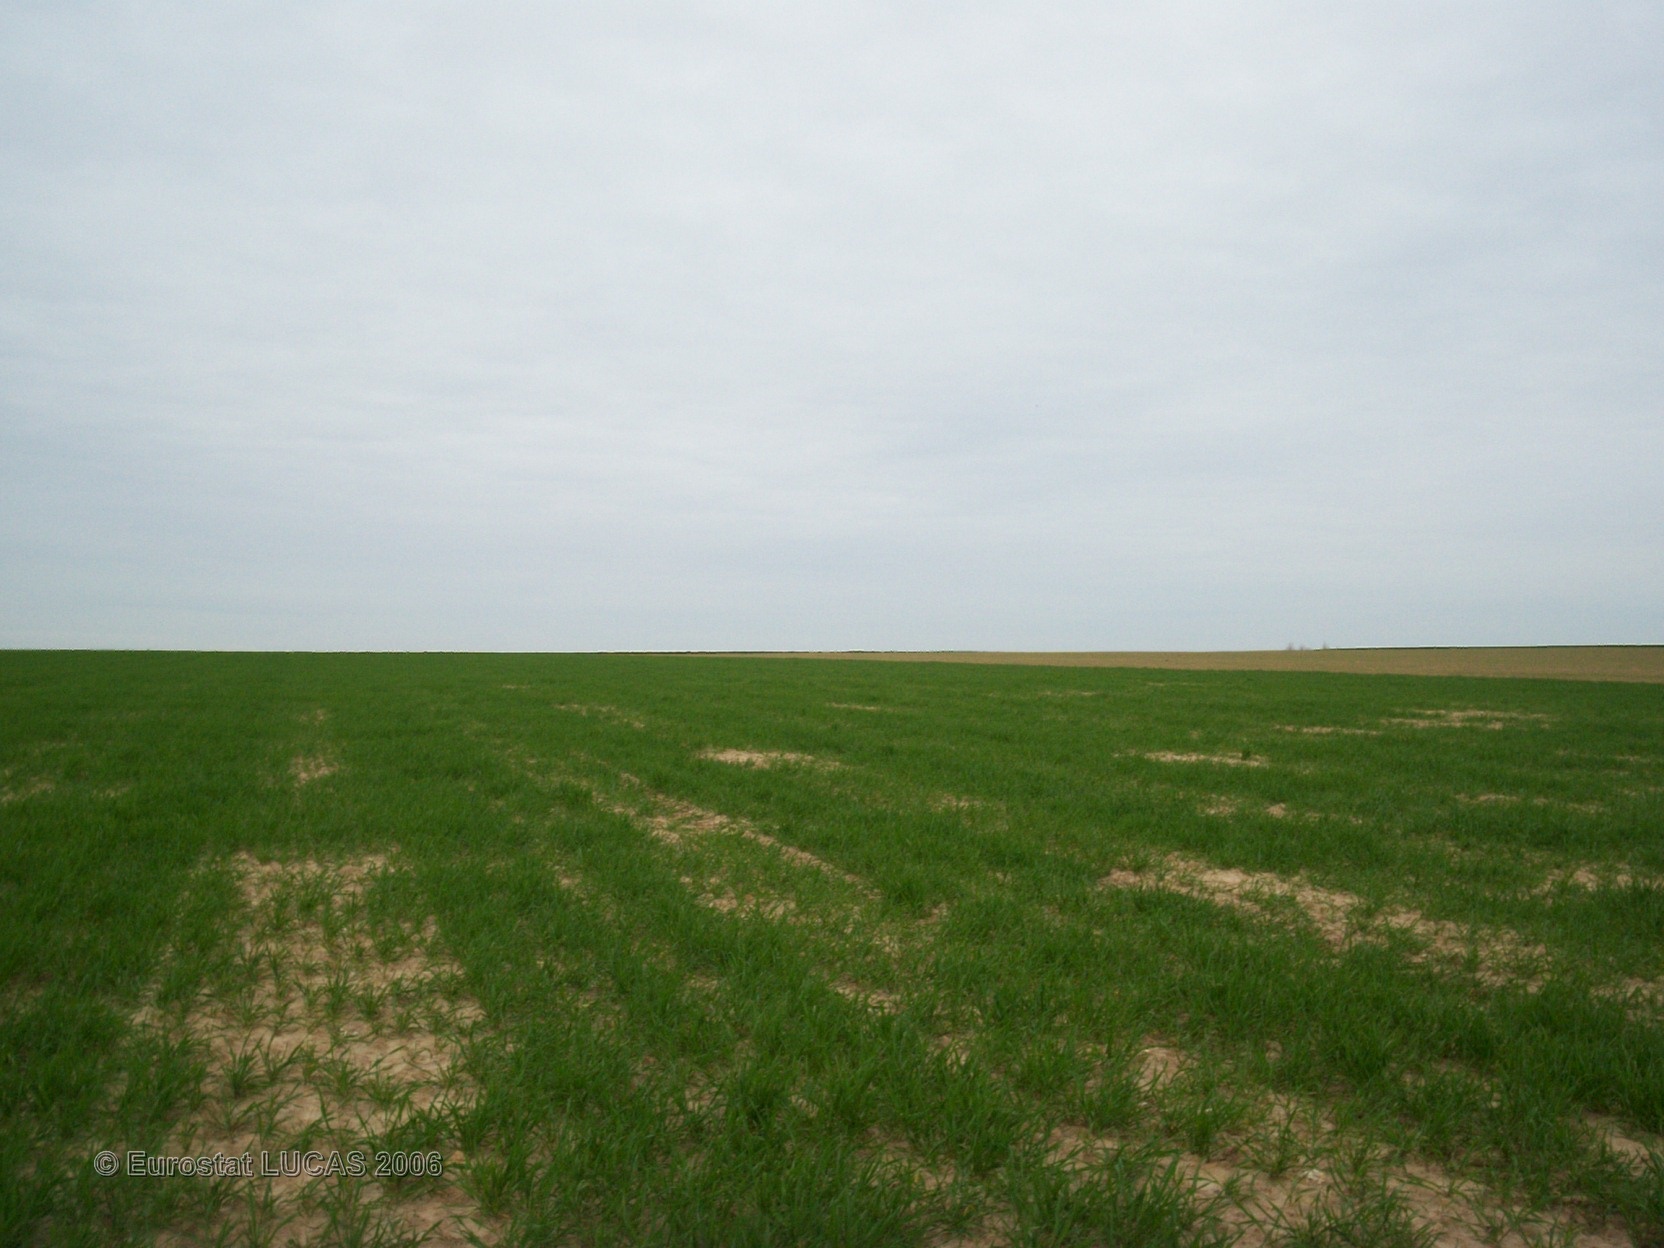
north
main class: Cropland
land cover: Common wheat
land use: Agriculture (excluding fallow land and kitchen gardens)
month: April
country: FR
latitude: 49.8642
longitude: 0.7797
